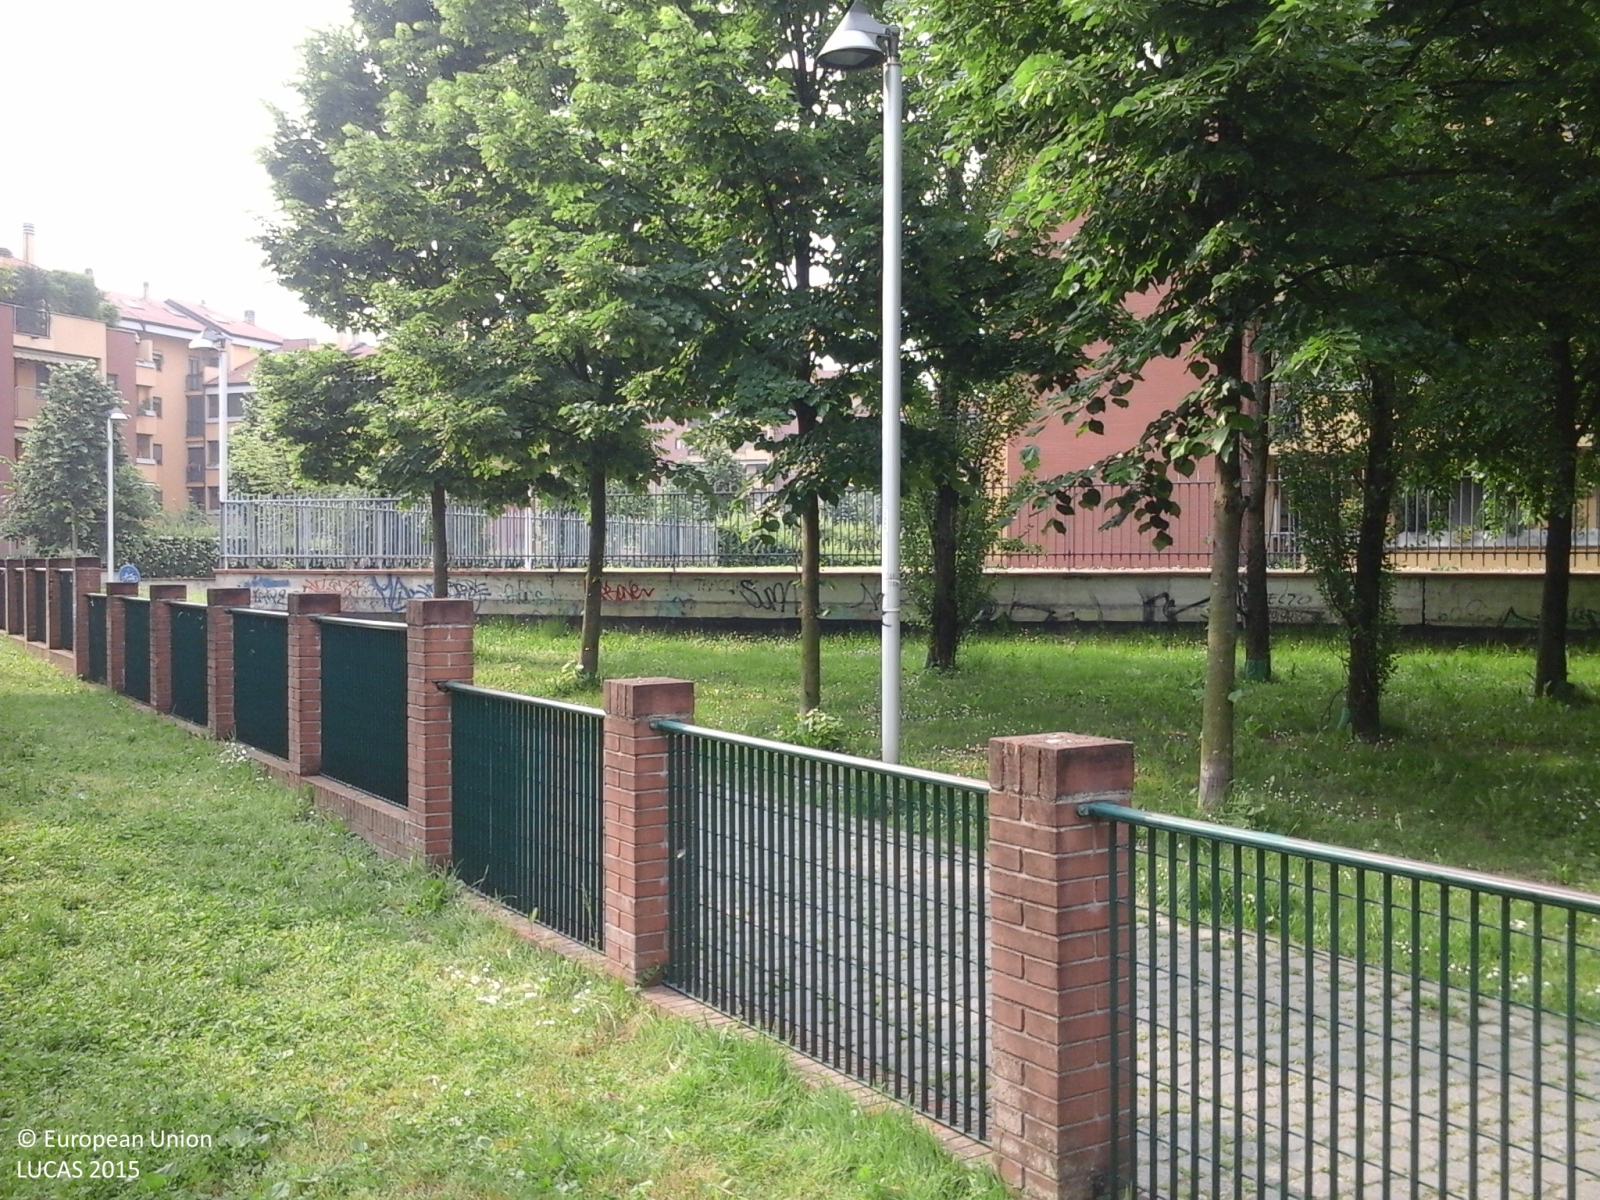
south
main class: Woodland
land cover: Broadleaved woodland
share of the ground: > 75 %
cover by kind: broadleaved forest trees 60 %, herbaceous plants 30 %, consolidated bare surface 10 %
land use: Amenities, museums, leisure
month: May
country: IT
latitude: 45.3930
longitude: 9.1712
